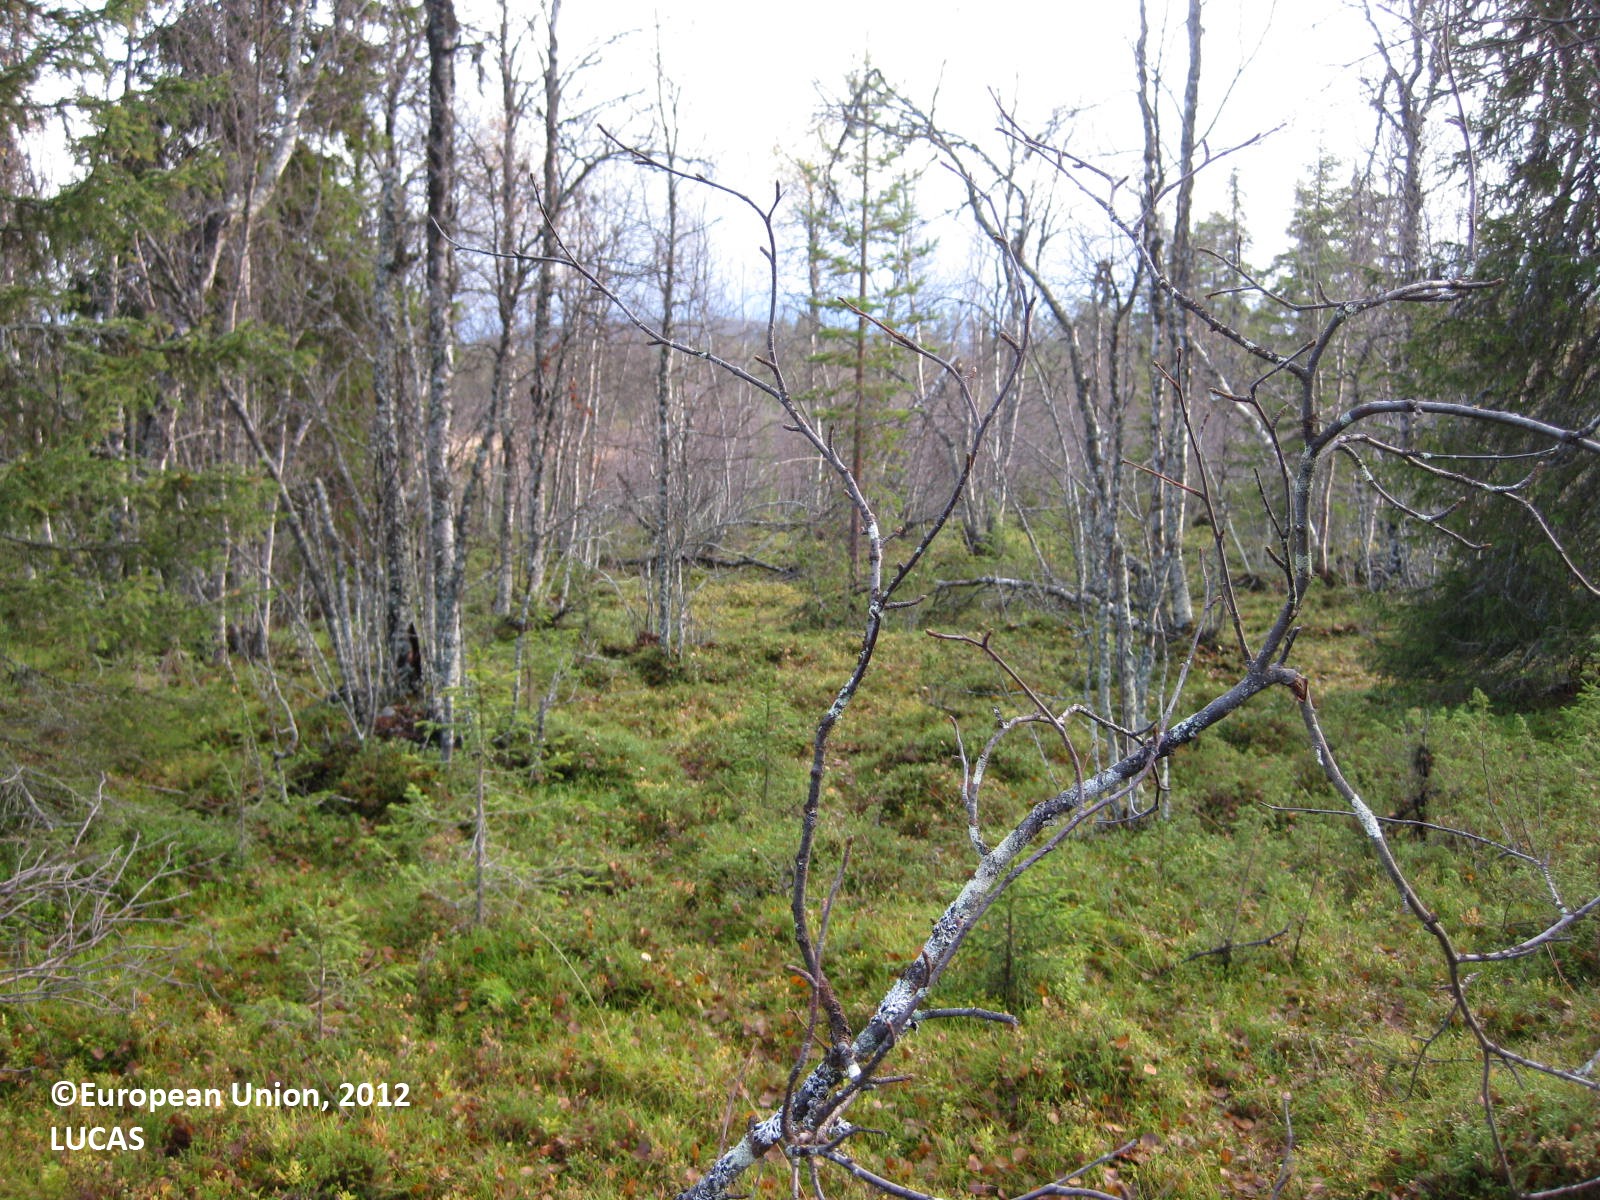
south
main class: Woodland
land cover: Other mixed woodland
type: boreal forest
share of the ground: 50 - 75 %
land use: Forestry
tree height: > 5 m
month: September
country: FI
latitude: 68.2688
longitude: 24.3198
